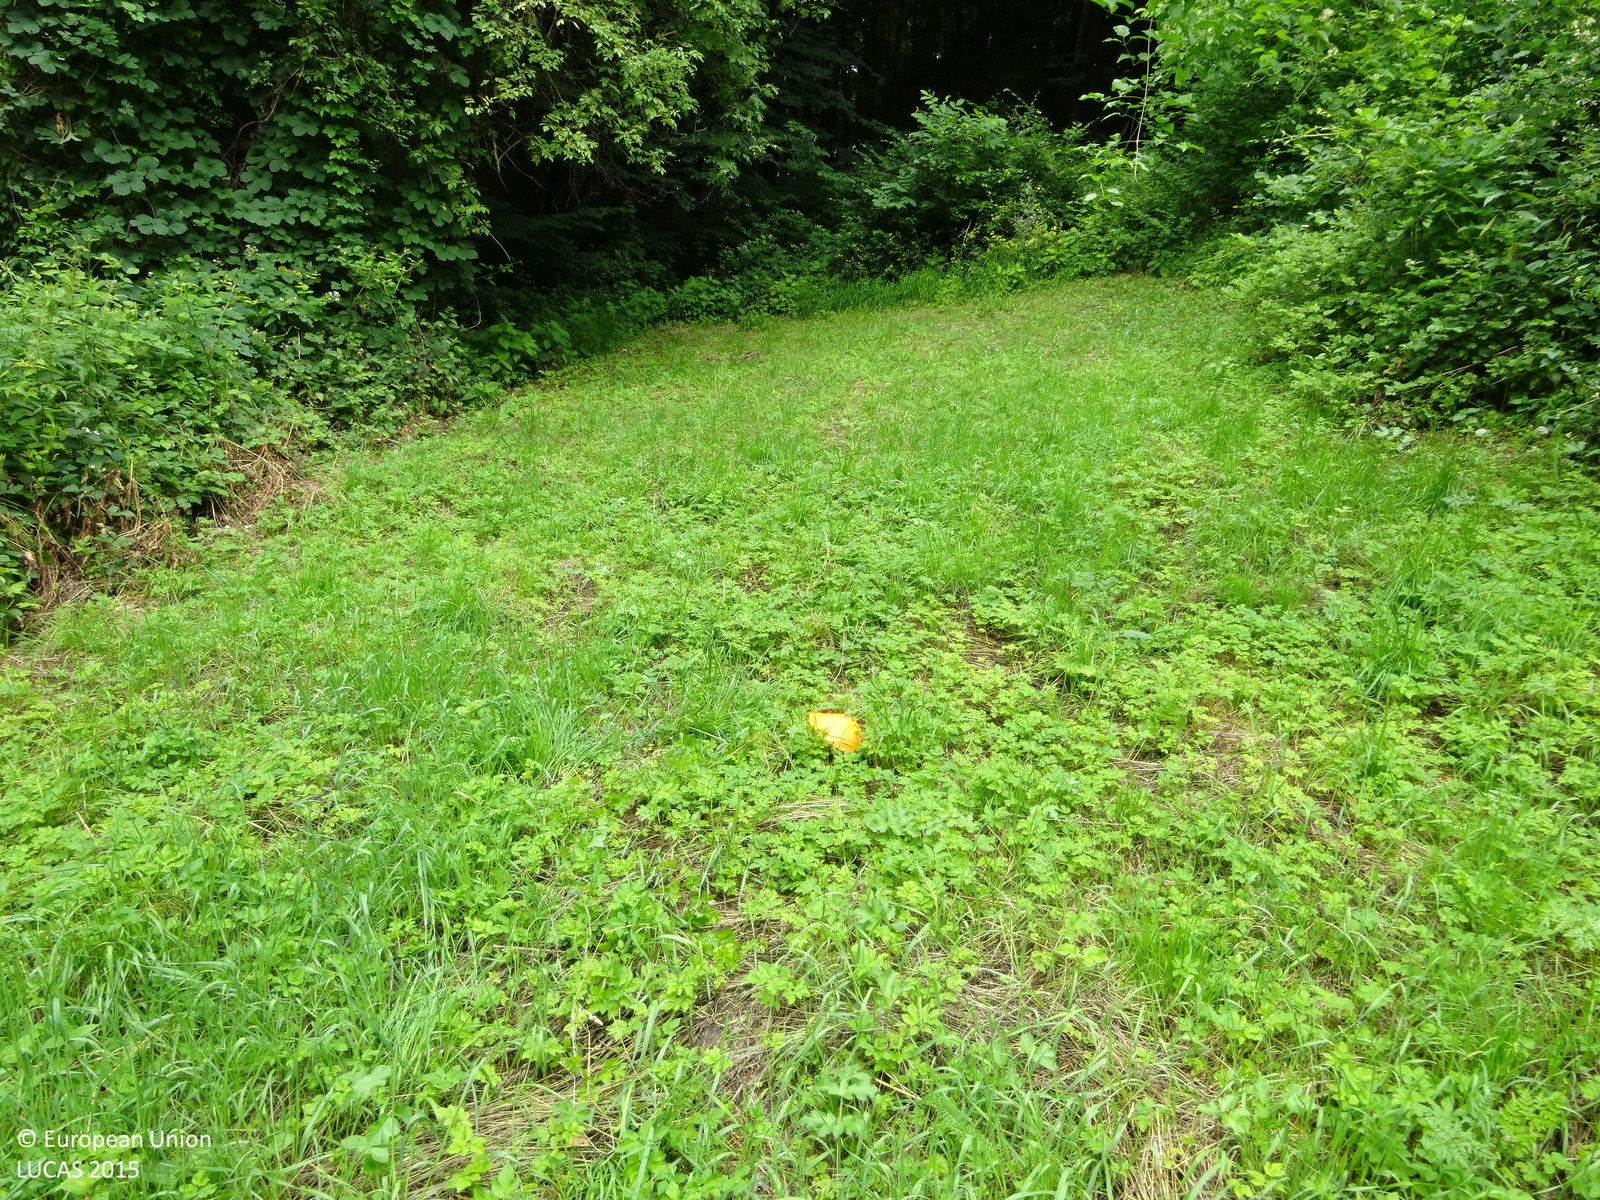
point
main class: Grassland
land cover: Grassland without tree/shrub cover
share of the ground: > 75 %
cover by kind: herbaceous plants 100 %
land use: Agriculture (excluding fallow land and kitchen gardens)
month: June
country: AT
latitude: 46.7174
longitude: 15.4545
